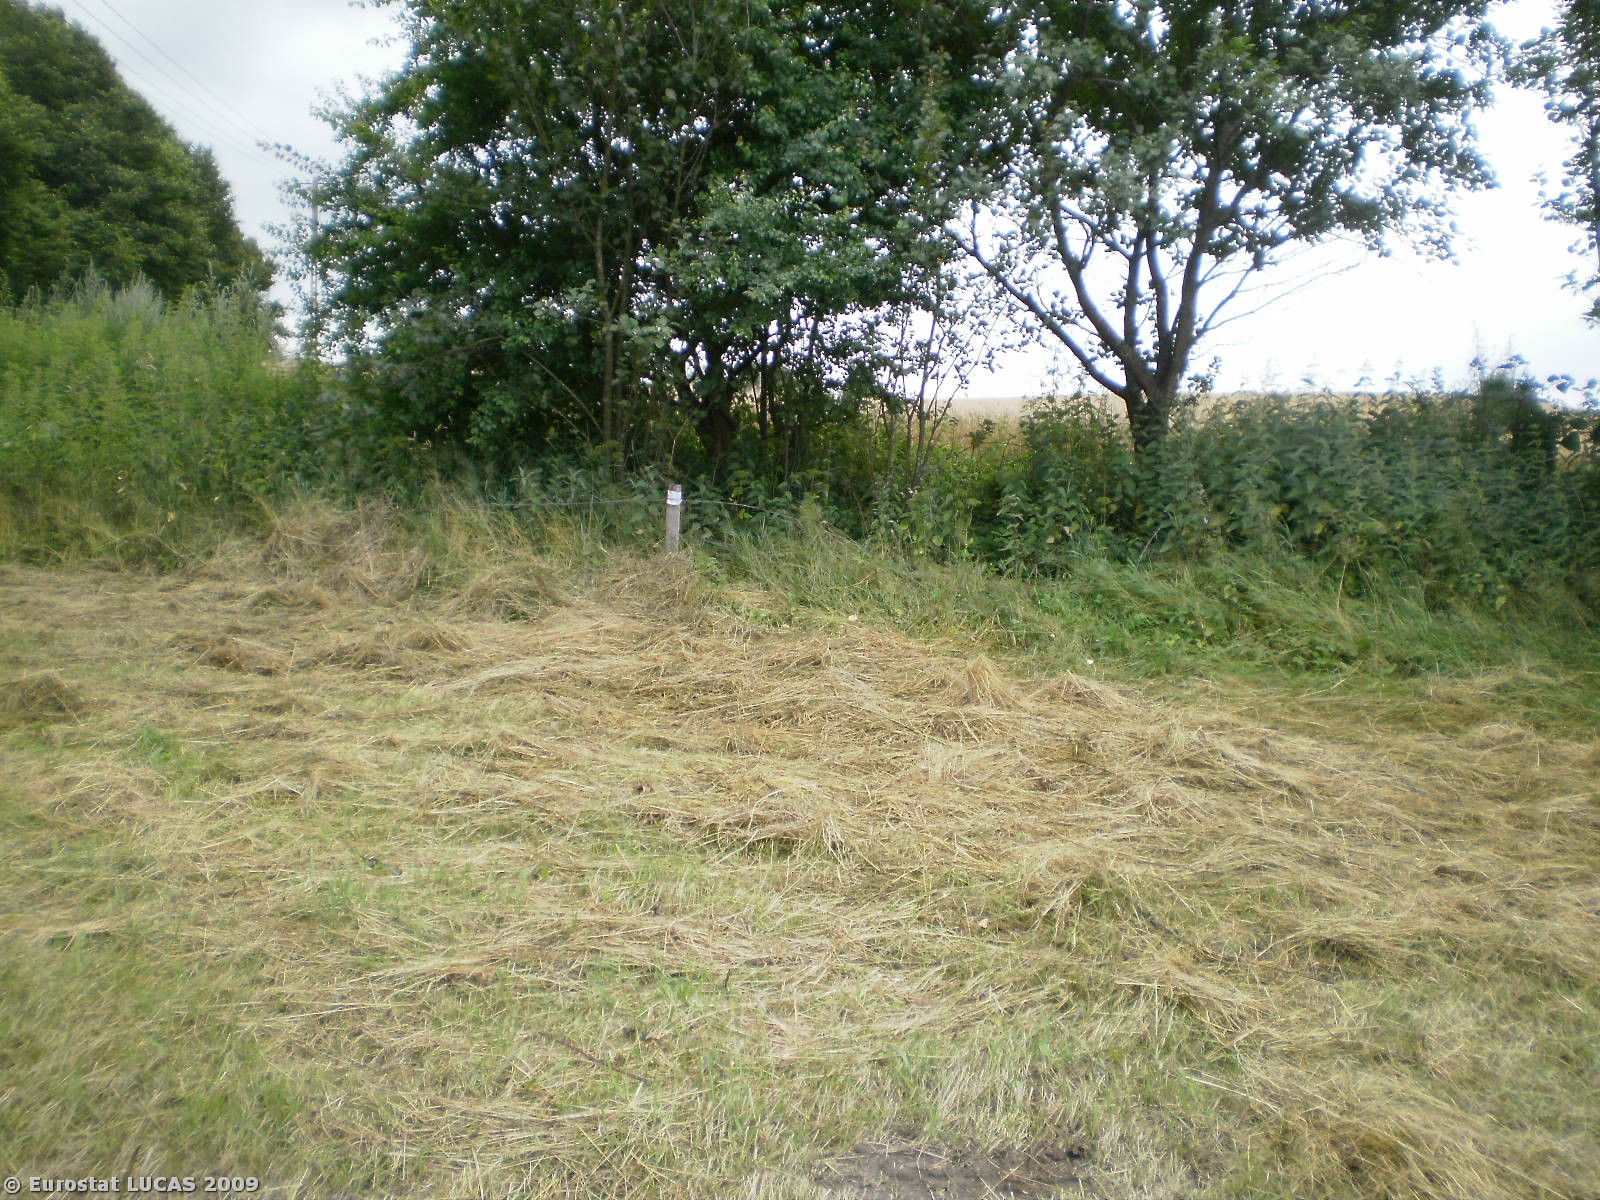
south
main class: Grassland
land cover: Grassland without tree/shrub cover
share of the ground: > 75 %
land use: Agriculture (excluding fallow land and kitchen gardens)
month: July
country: PL
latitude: 54.2131
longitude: 20.0753
